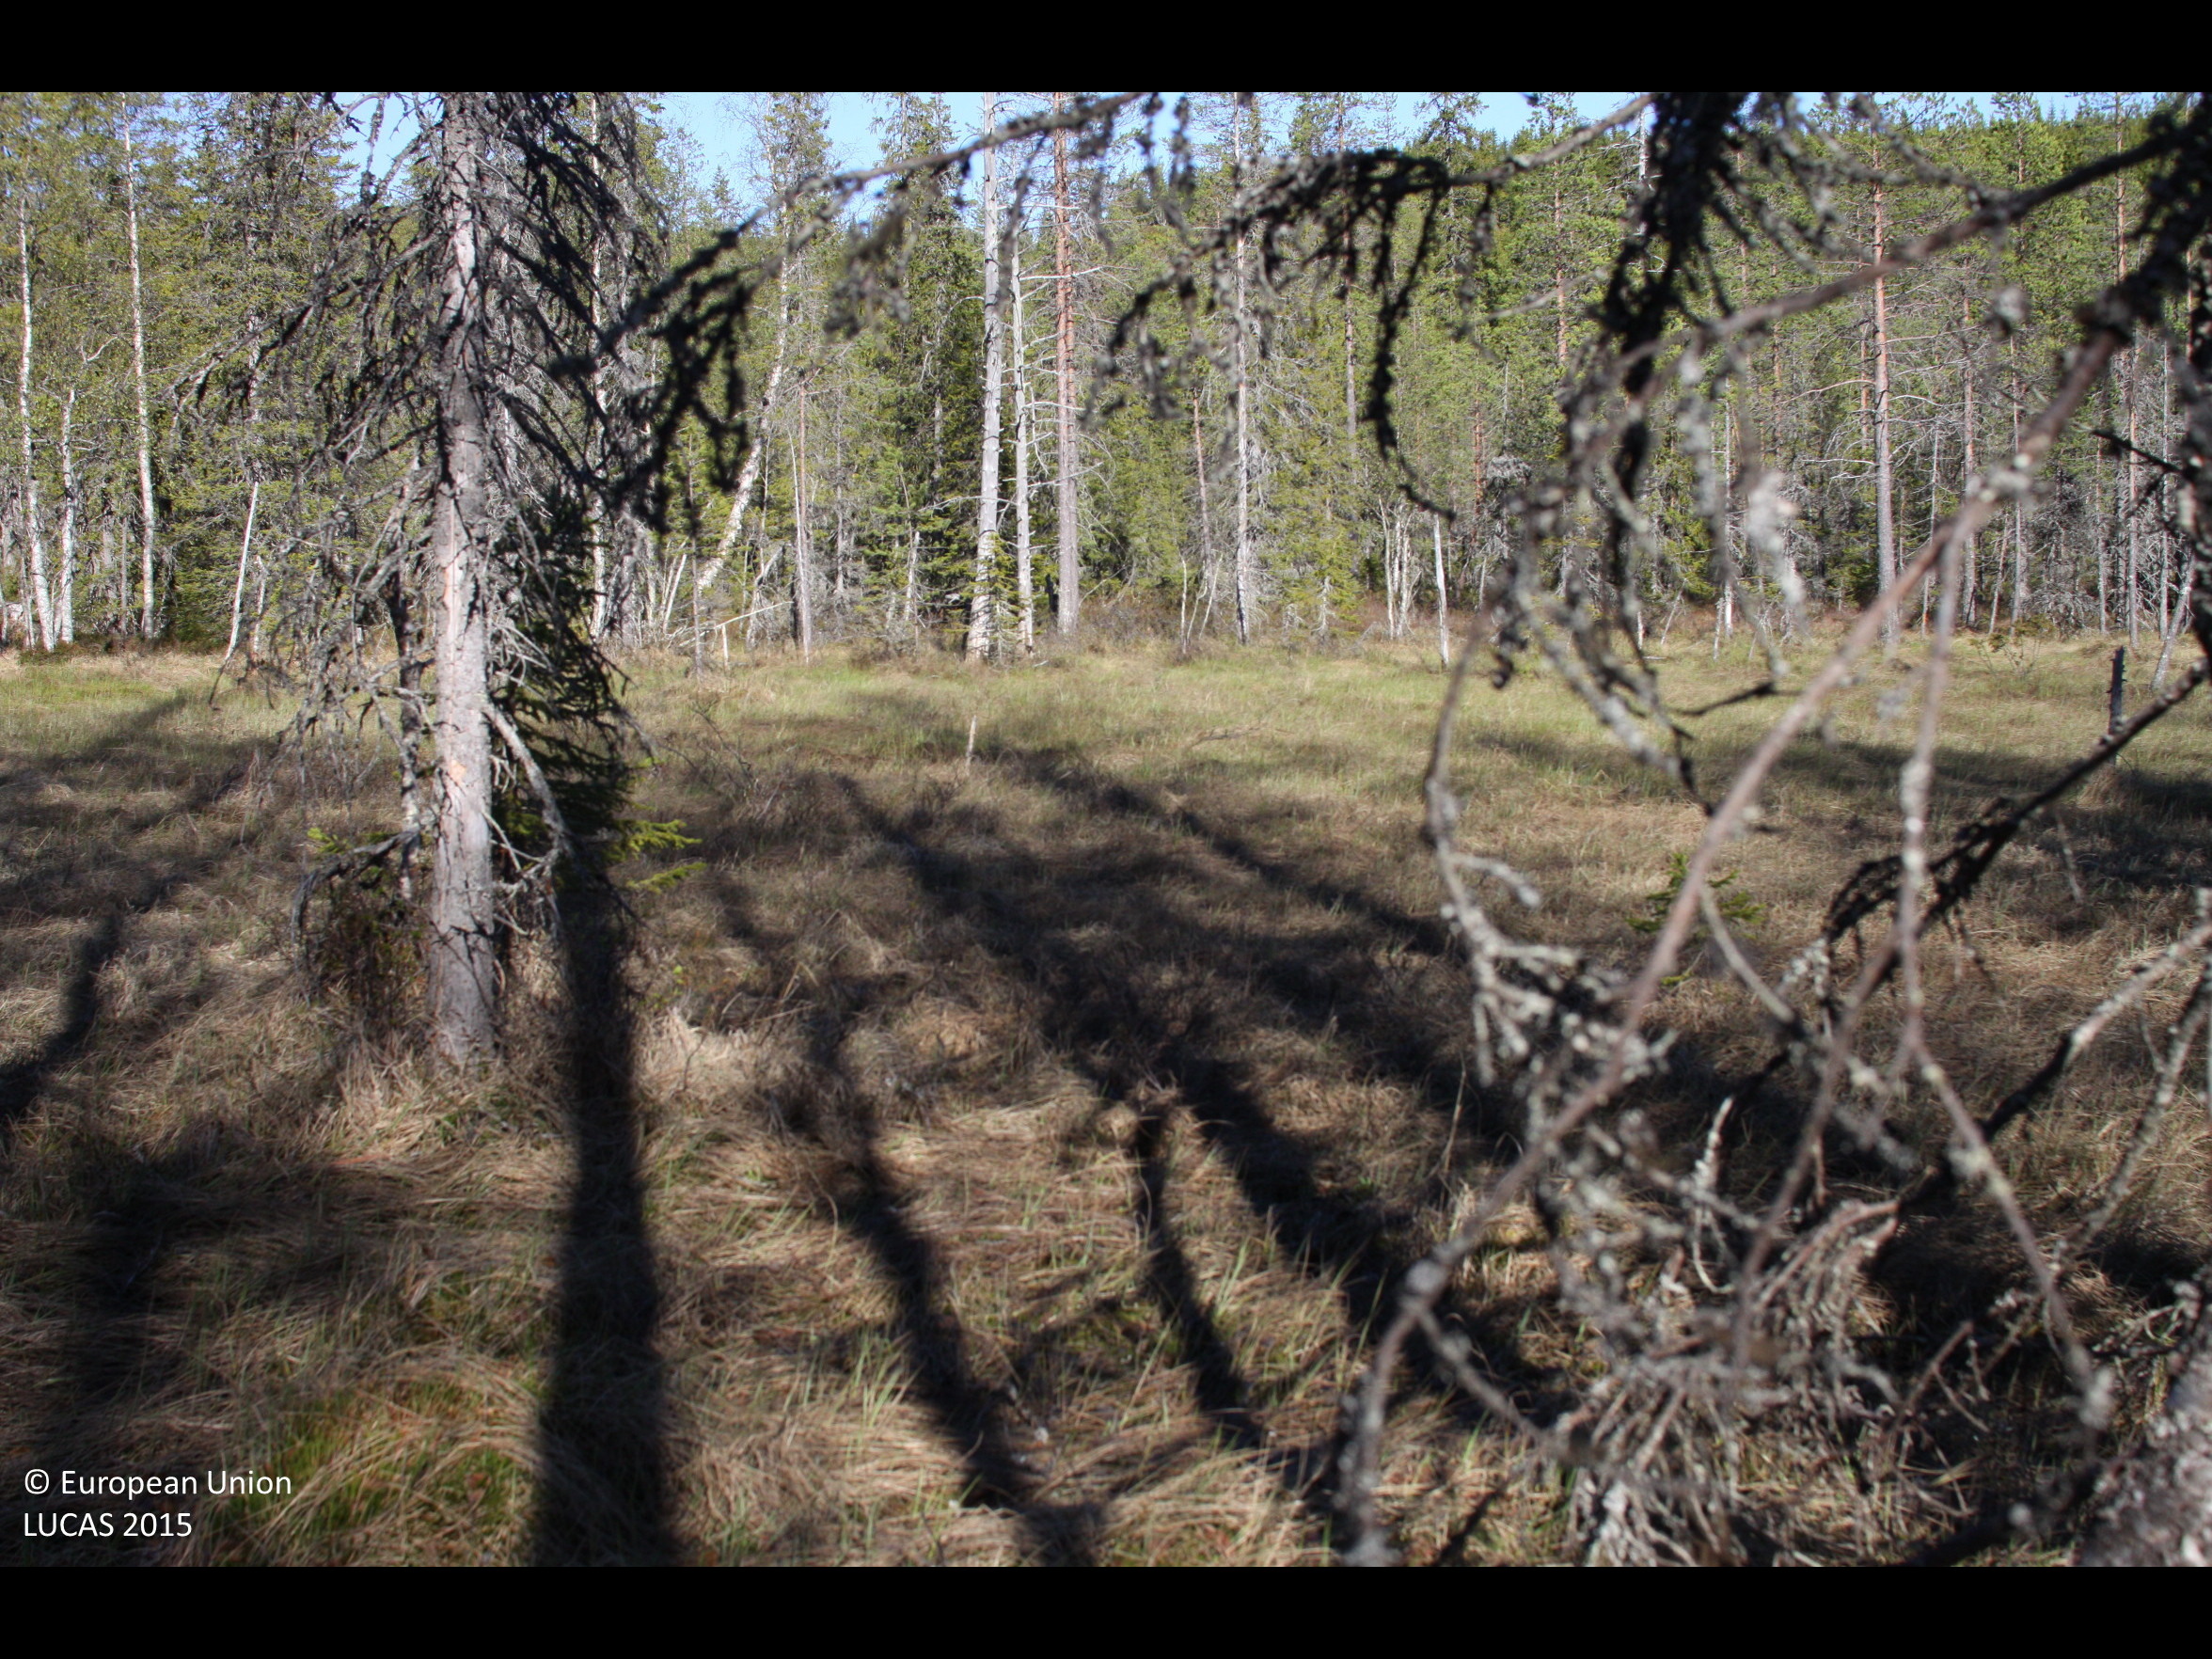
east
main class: Woodland
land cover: Spruce dominated mixed woodland
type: boreal forest
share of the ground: > 75 %
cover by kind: coniferous forest trees 45 %, broadleaved forest trees 35 %, herbaceous plants 10 %, lichens and mosses 10 %
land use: Forestry
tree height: > 5 m
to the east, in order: Spruce dominated mixed woodland; Peatbogs; Other coniferous woodland; Spruce dominated coniferous woodland; Rivers and streams; Spruce dominated coniferous woodland
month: June
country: FI
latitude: 66.2462
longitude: 27.4936
